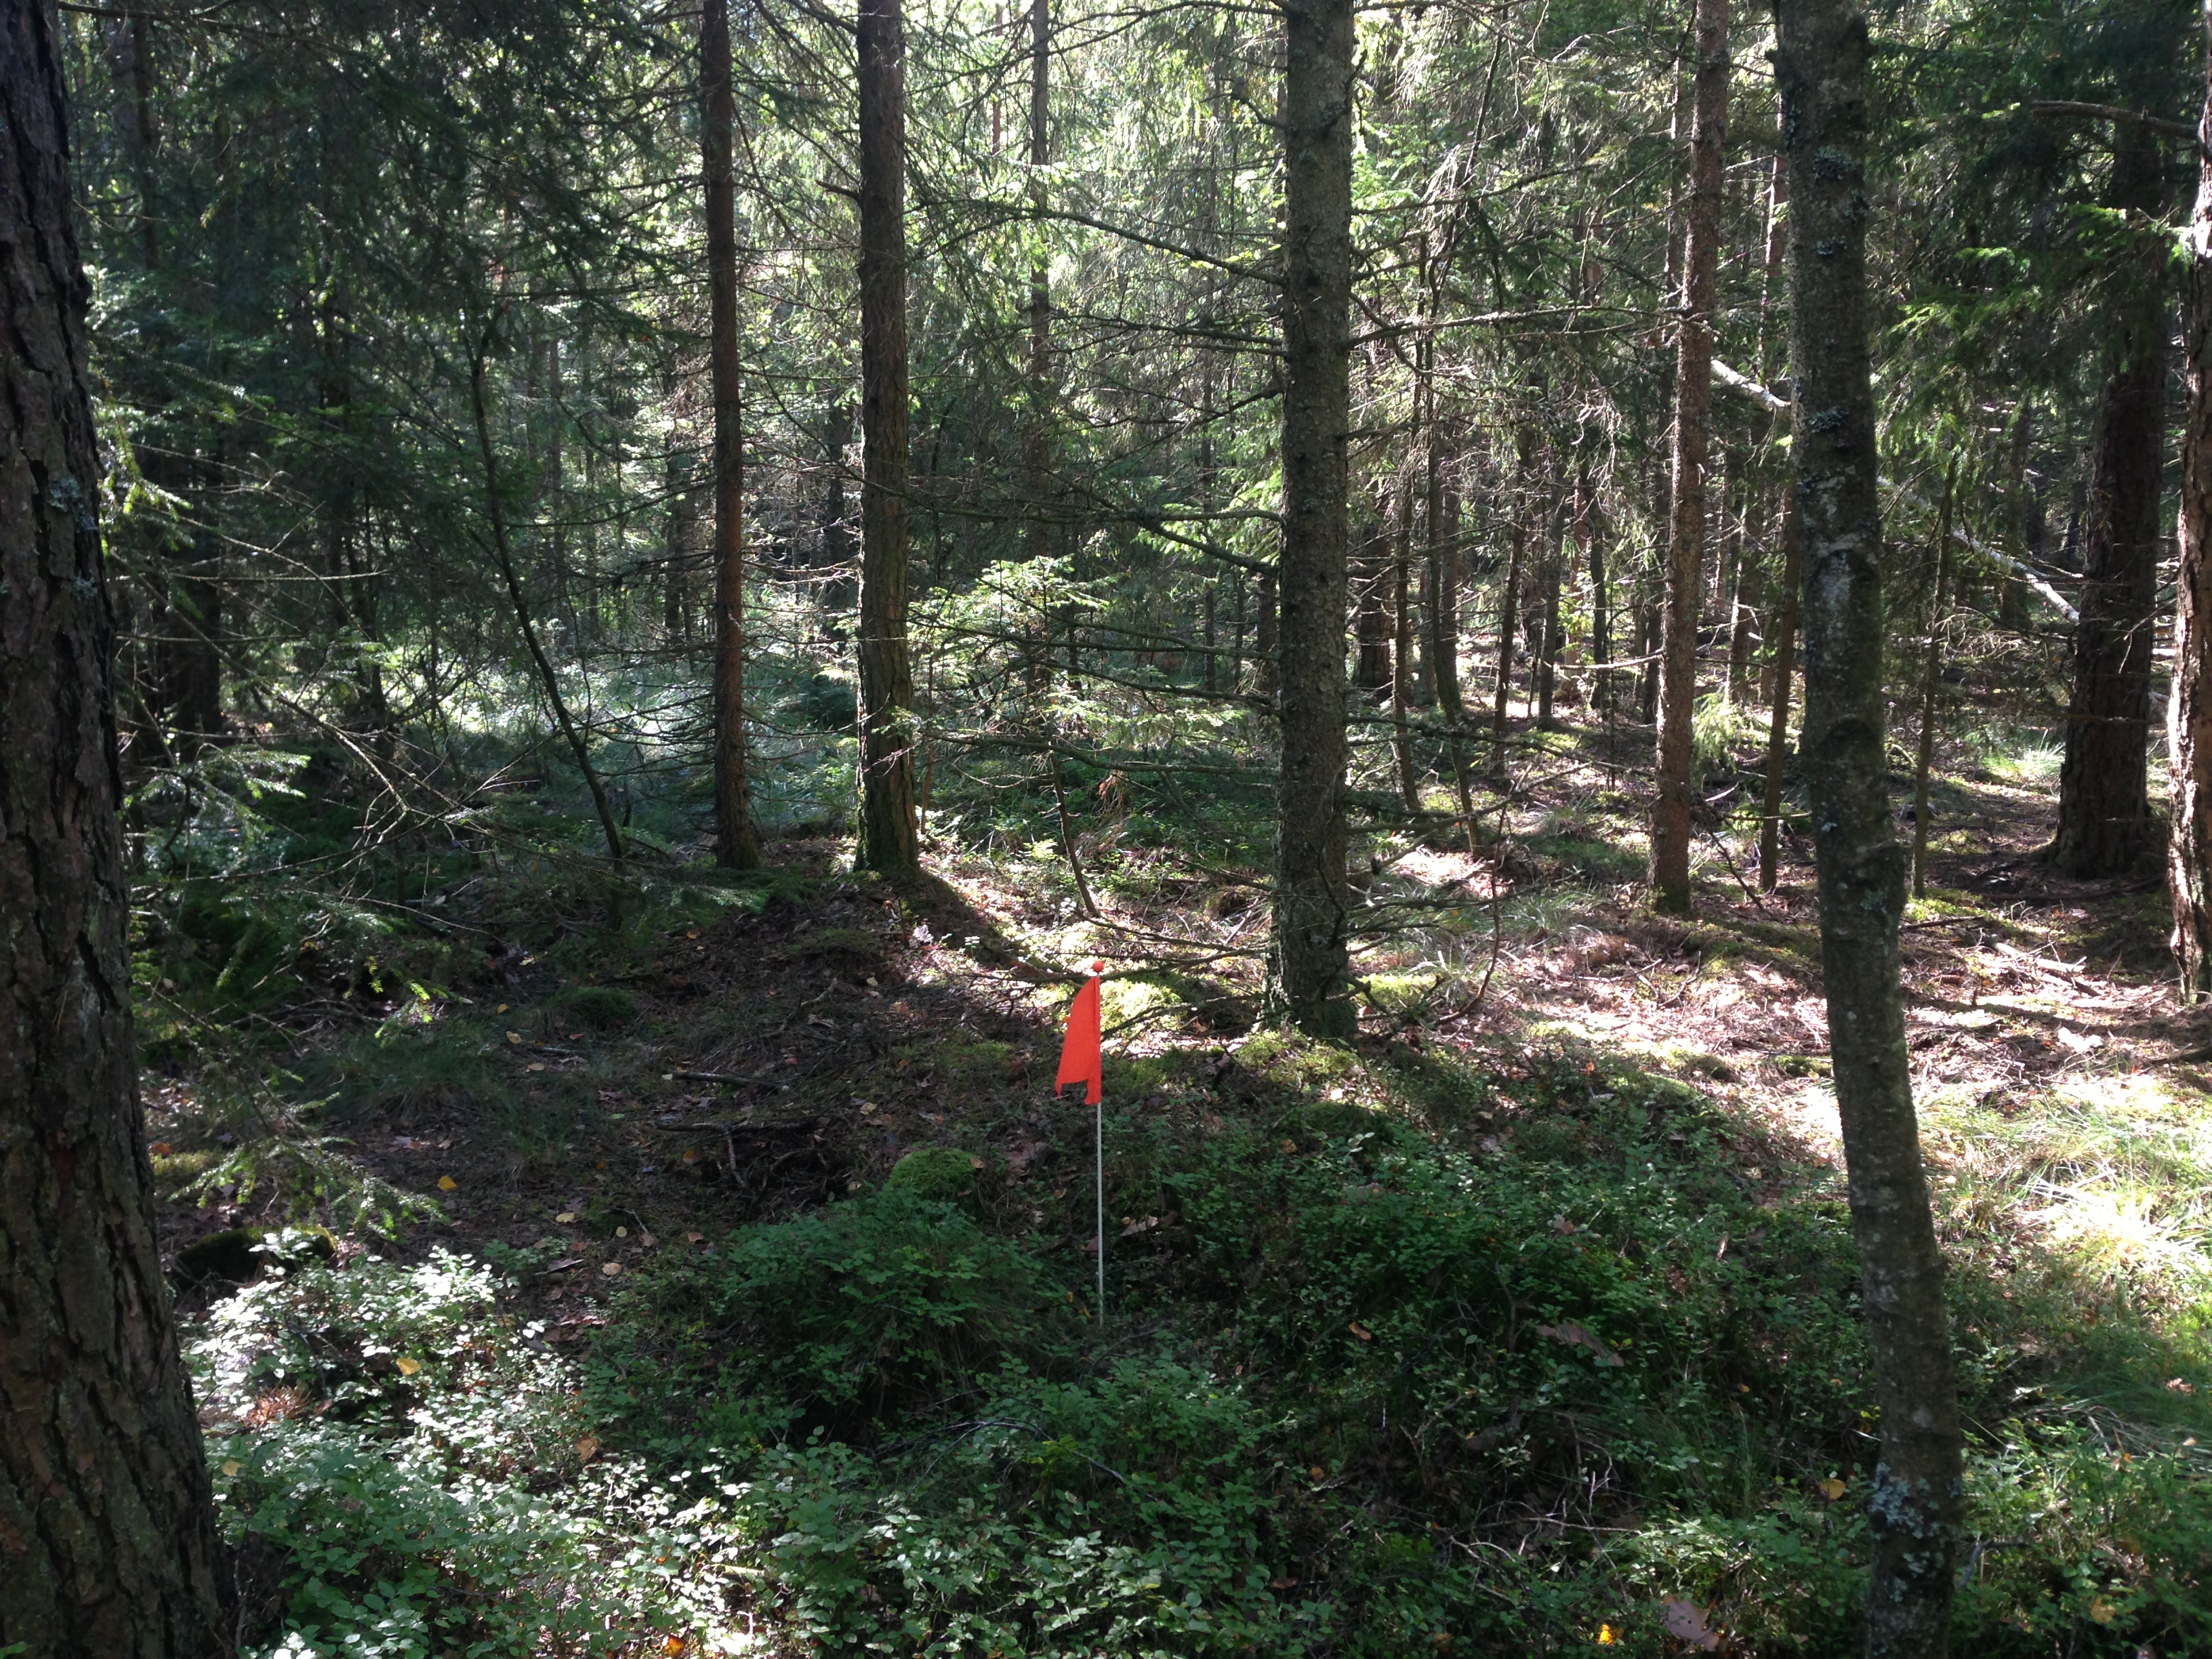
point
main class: Woodland
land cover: Pine dominated mixed woodland
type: boreal forest
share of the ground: > 75 %
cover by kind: coniferous forest trees 50 %, broadleaved forest trees 30 %, shrubs 20 %
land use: Forestry
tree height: > 5 m
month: September
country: SE
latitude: 57.1183
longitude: 13.2497
